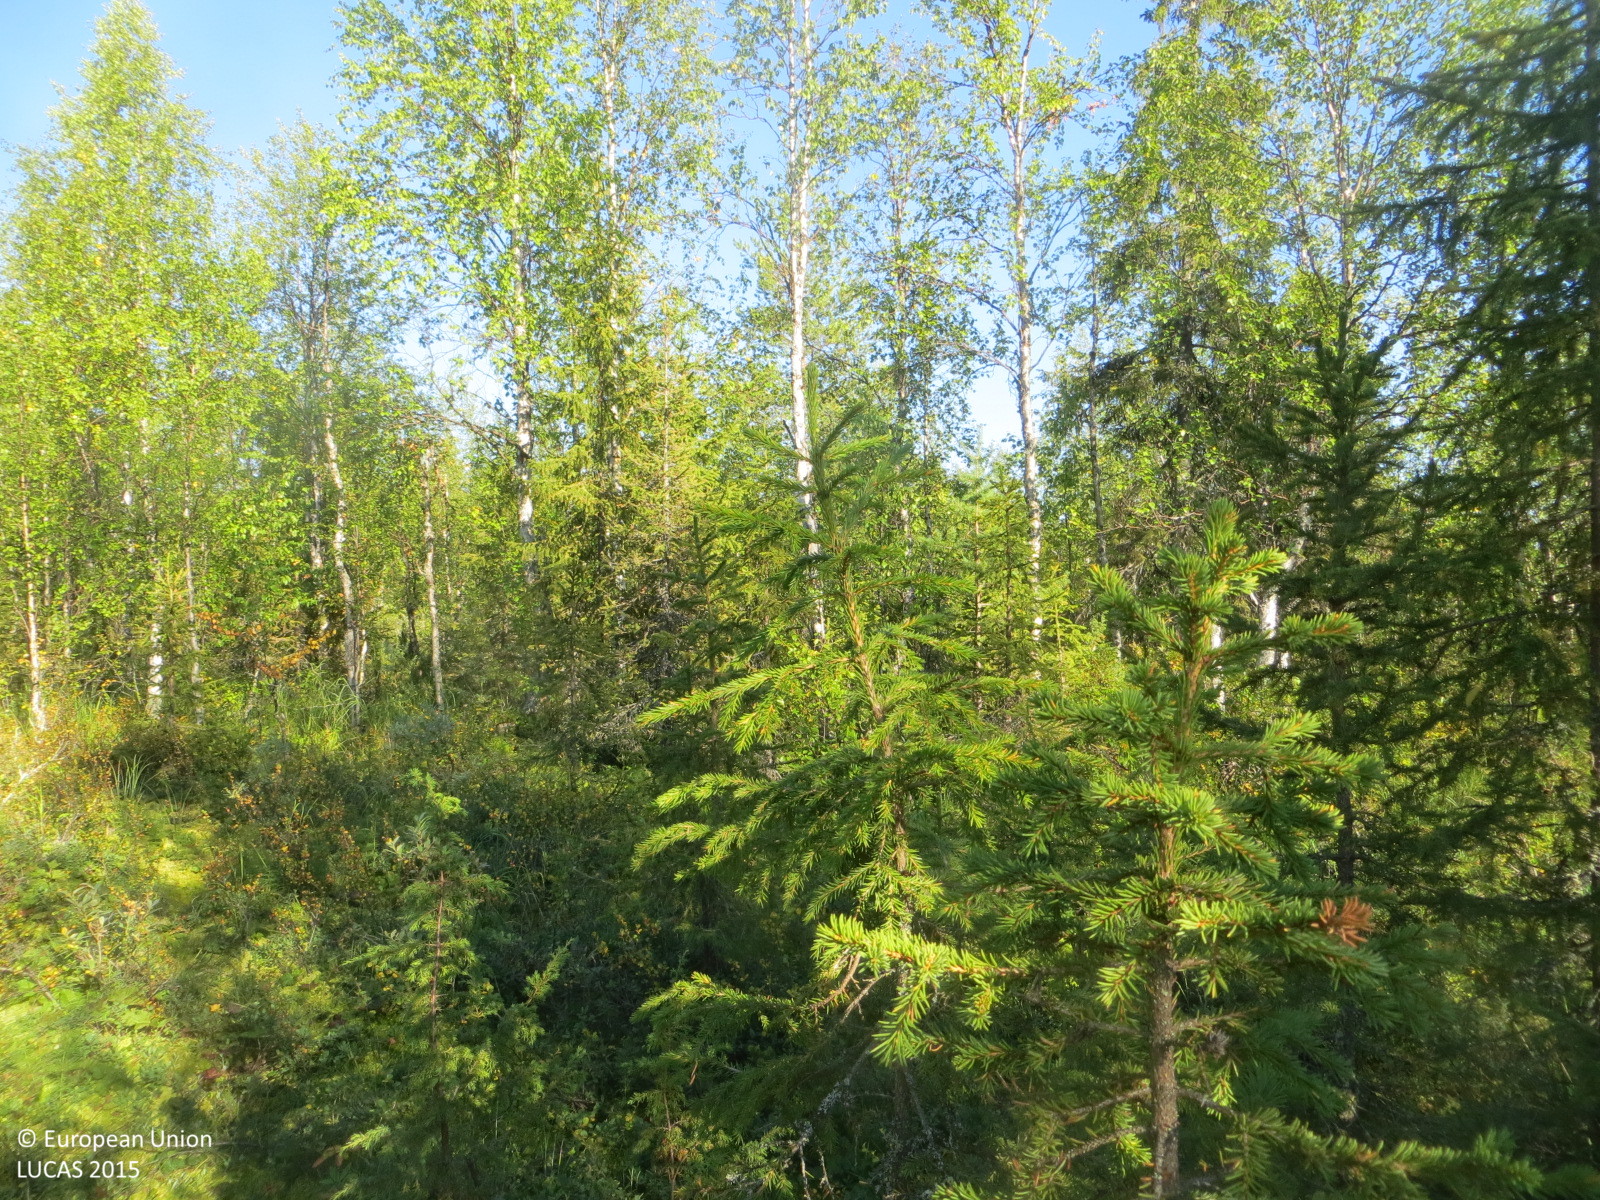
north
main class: Woodland
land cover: Spruce dominated mixed woodland
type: mire and swamp forests
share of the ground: 50 - 75 %
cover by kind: broadleaved forest trees 35 %, shrubs 35 %, coniferous forest trees 30 %
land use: Forestry
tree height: > 5 m
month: August
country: FI
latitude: 67.6148
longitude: 24.1654
